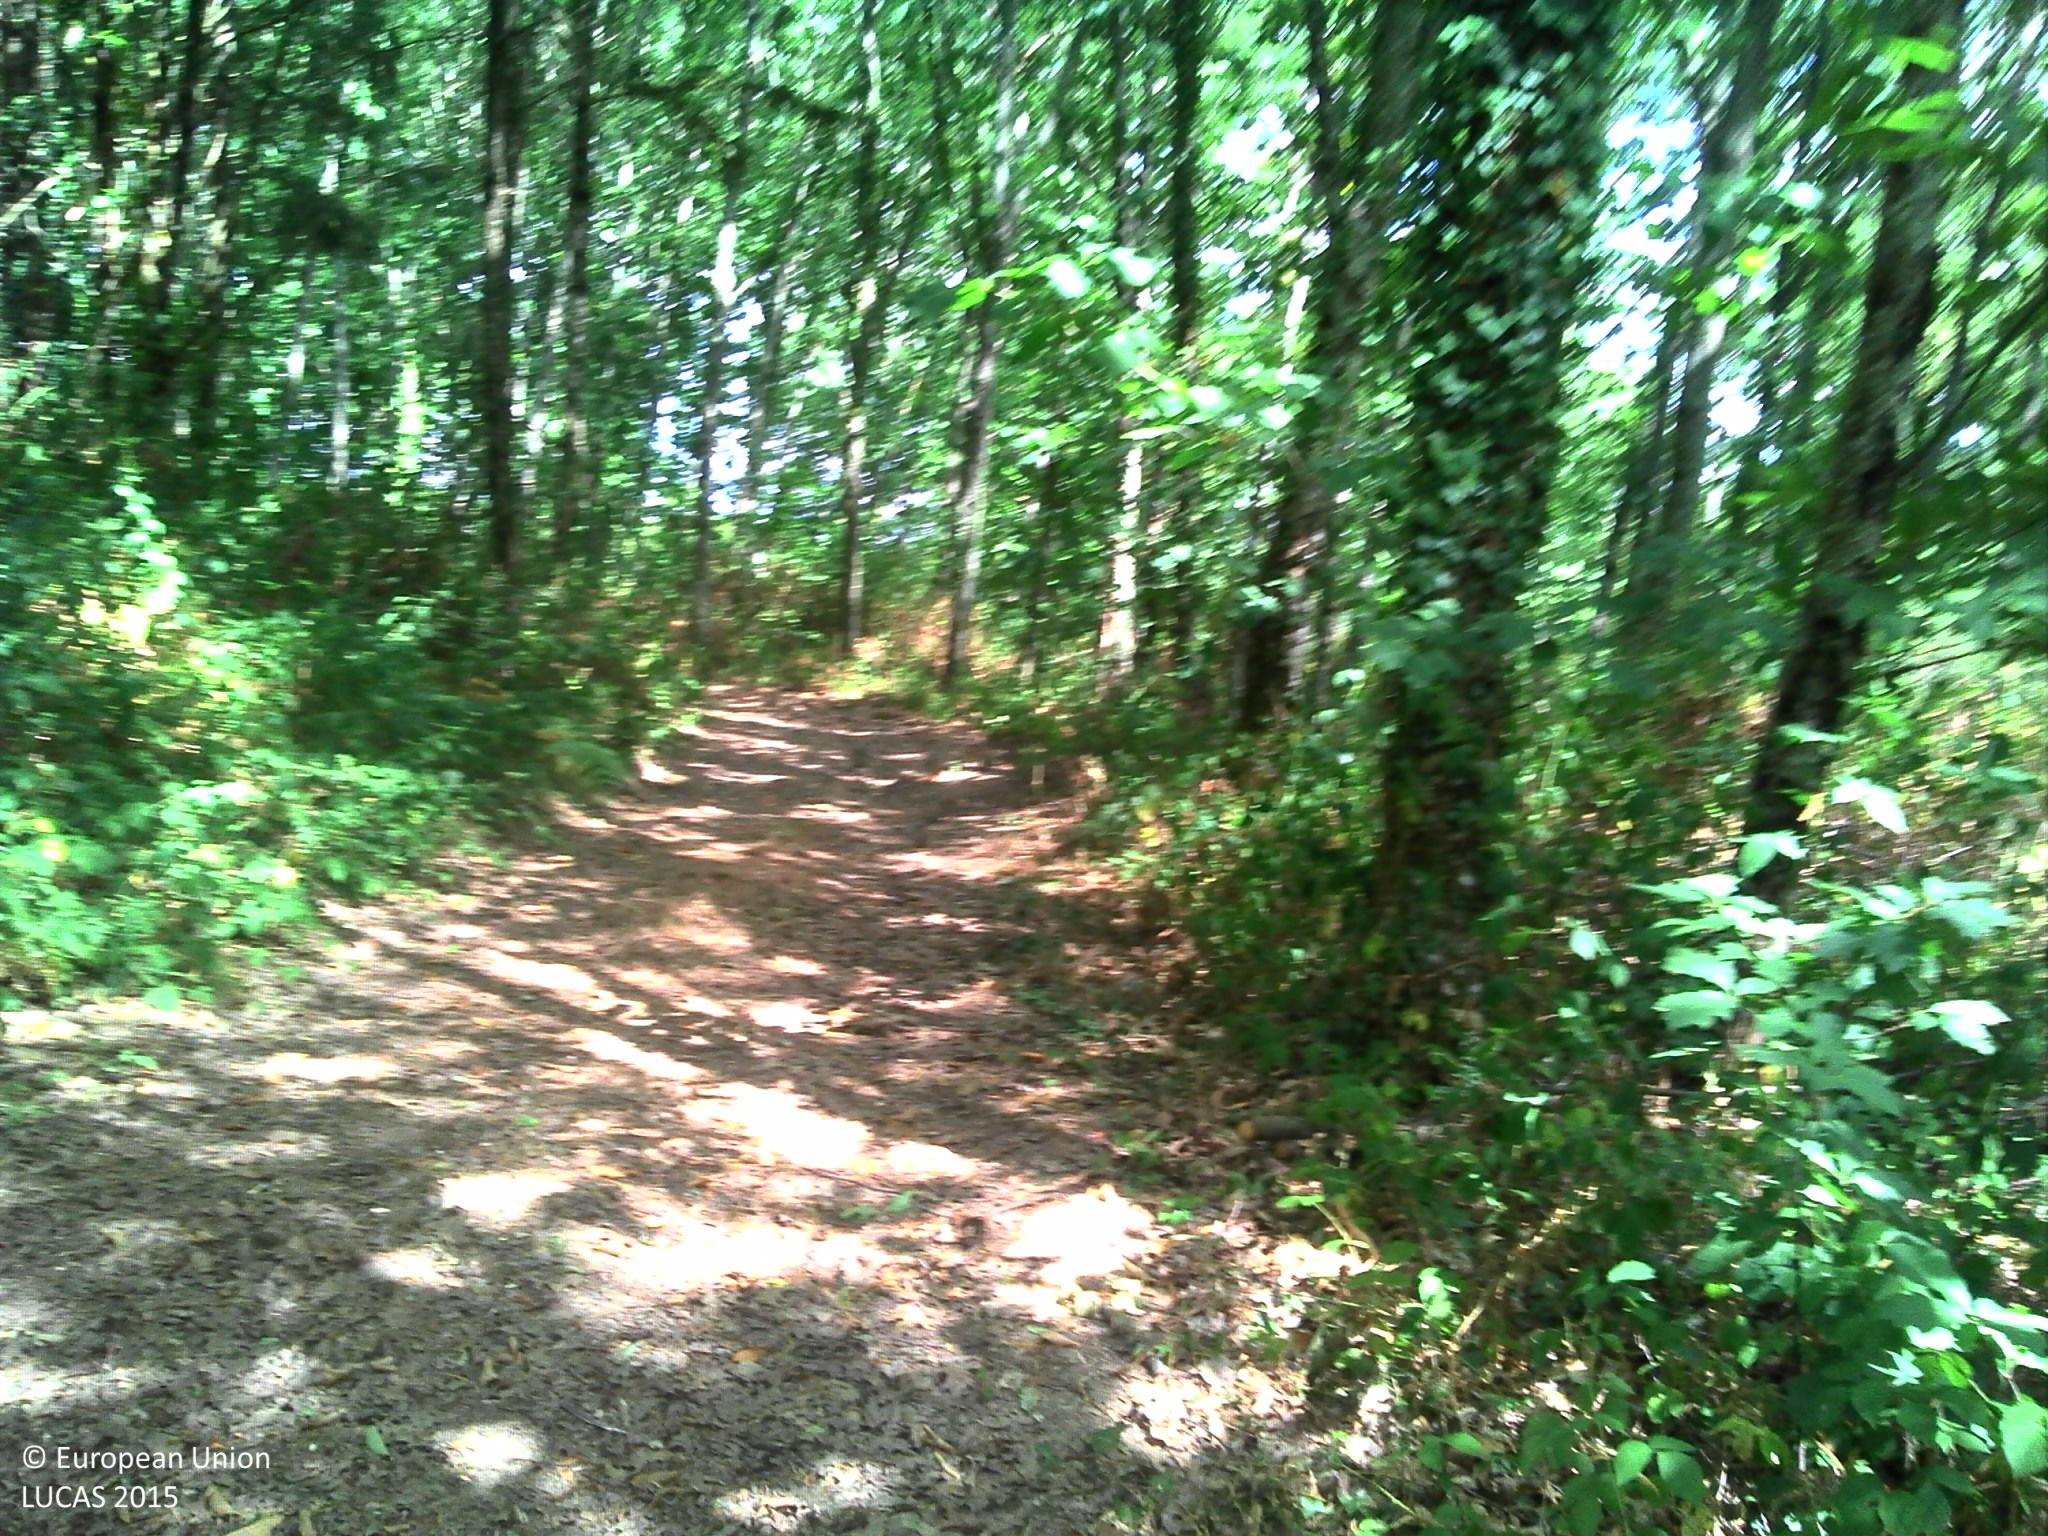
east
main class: Woodland
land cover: Broadleaved woodland
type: exotic forest
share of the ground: > 75 %
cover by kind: broadleaved forest trees 100 %
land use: Forestry
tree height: > 5 m
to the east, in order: Tracks; Broadleaved woodland; Grassland without tree/shrub cover; Rivers and streams; Grassland without tree/shrub cover; Ditches and canals; Grass margins; Paved roads, cycling and walking lanes; Grass margins; Abandoned hedges; Clovers
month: July
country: FR
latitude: 45.9706
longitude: 0.9933
